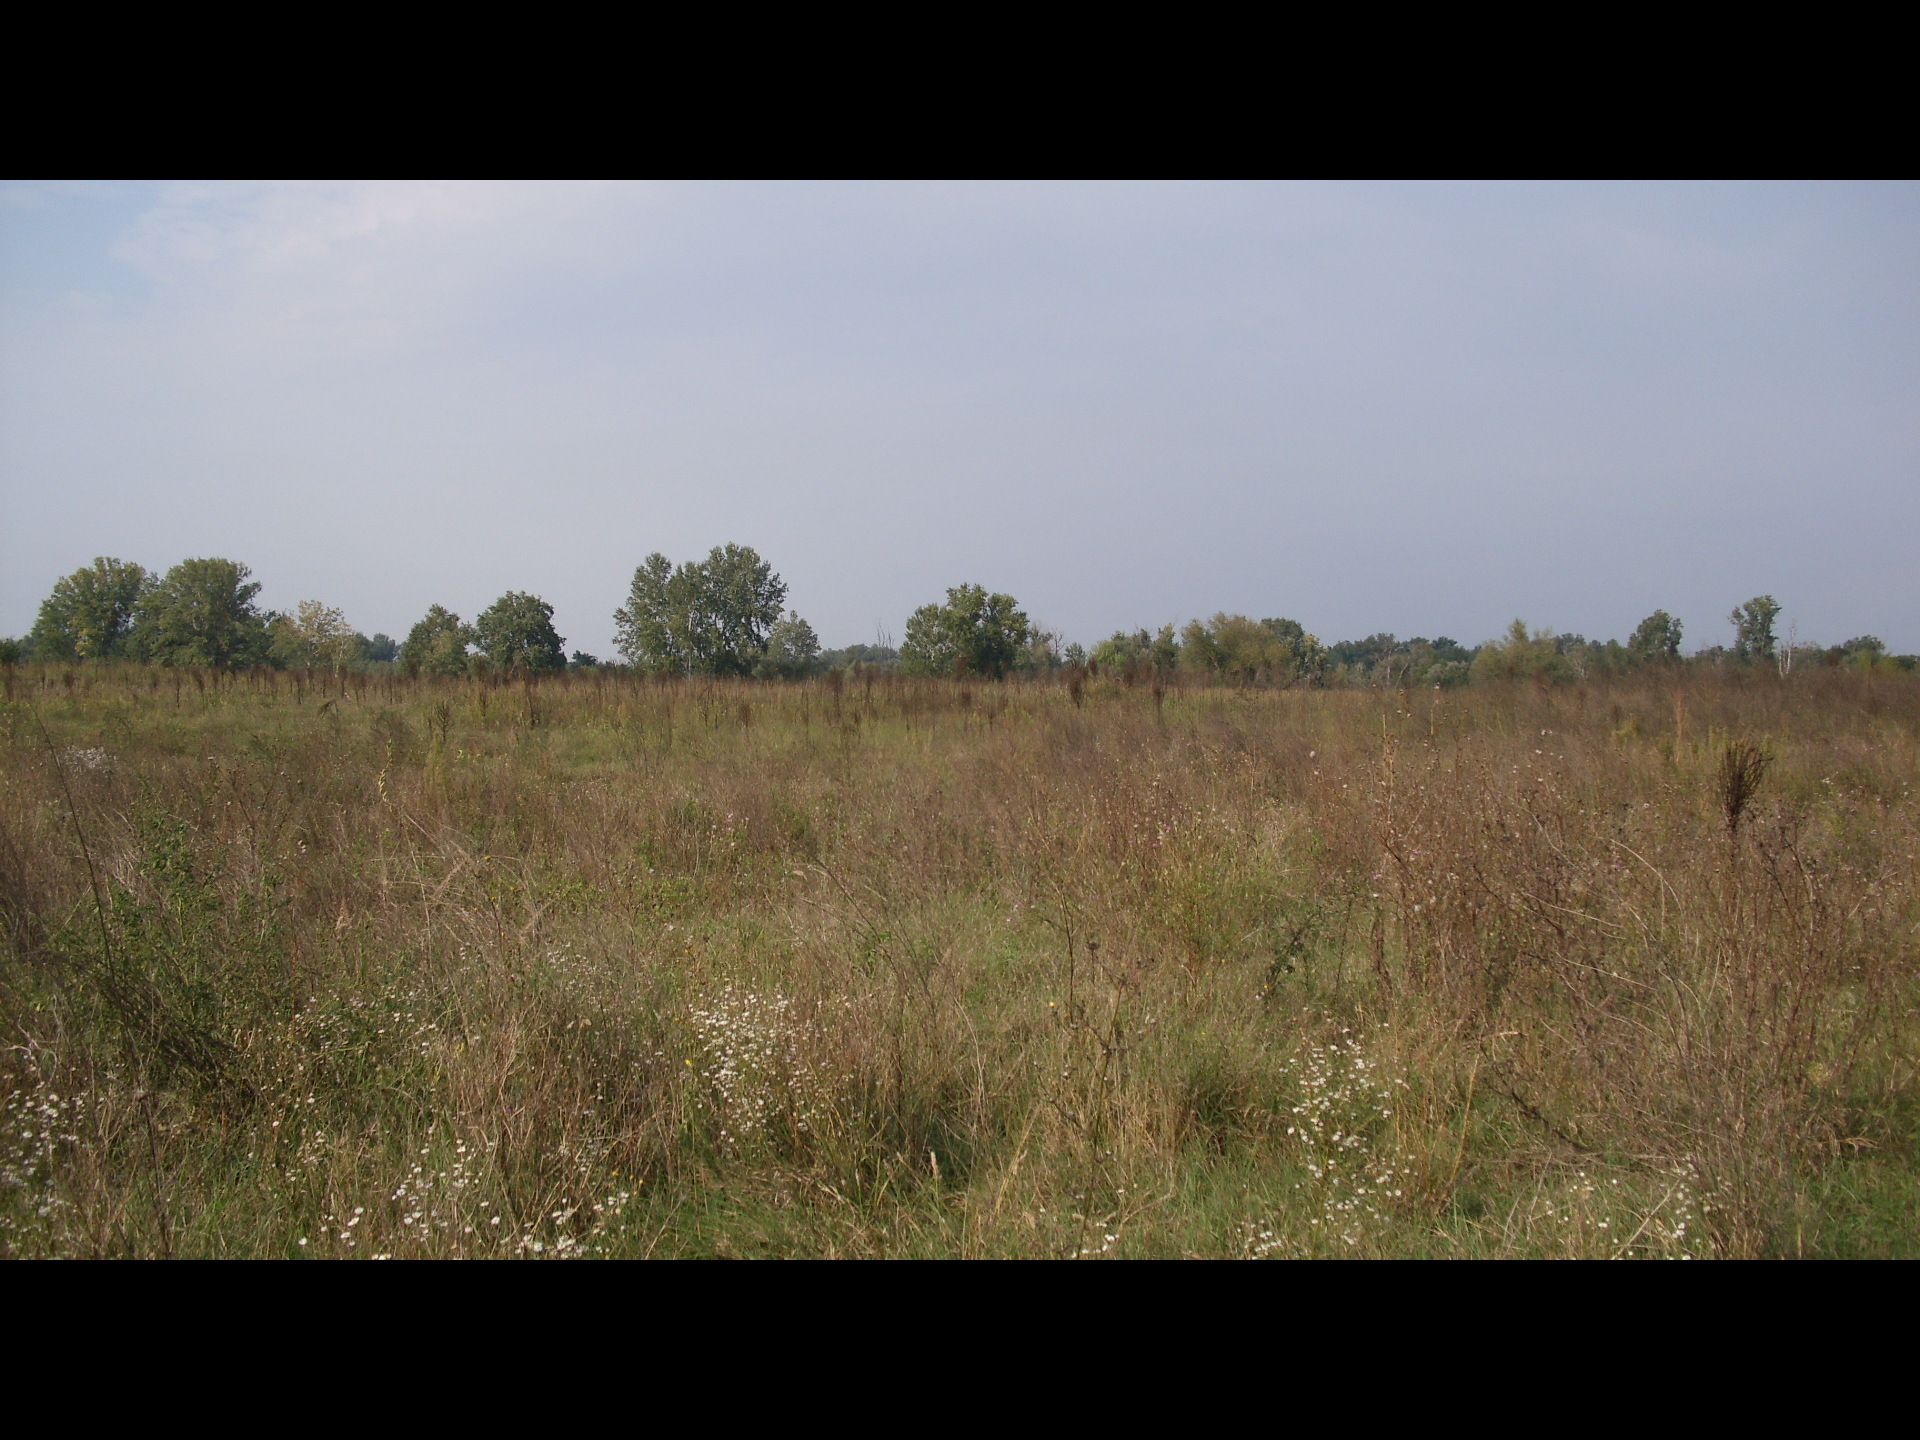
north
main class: Grassland
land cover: Spontaneously vegetated surfaces
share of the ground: > 75 %
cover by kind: herbaceous plants 100 %
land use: Abandoned areas
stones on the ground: < 10 %
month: September
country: BG
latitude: 43.7813
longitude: 23.0244
